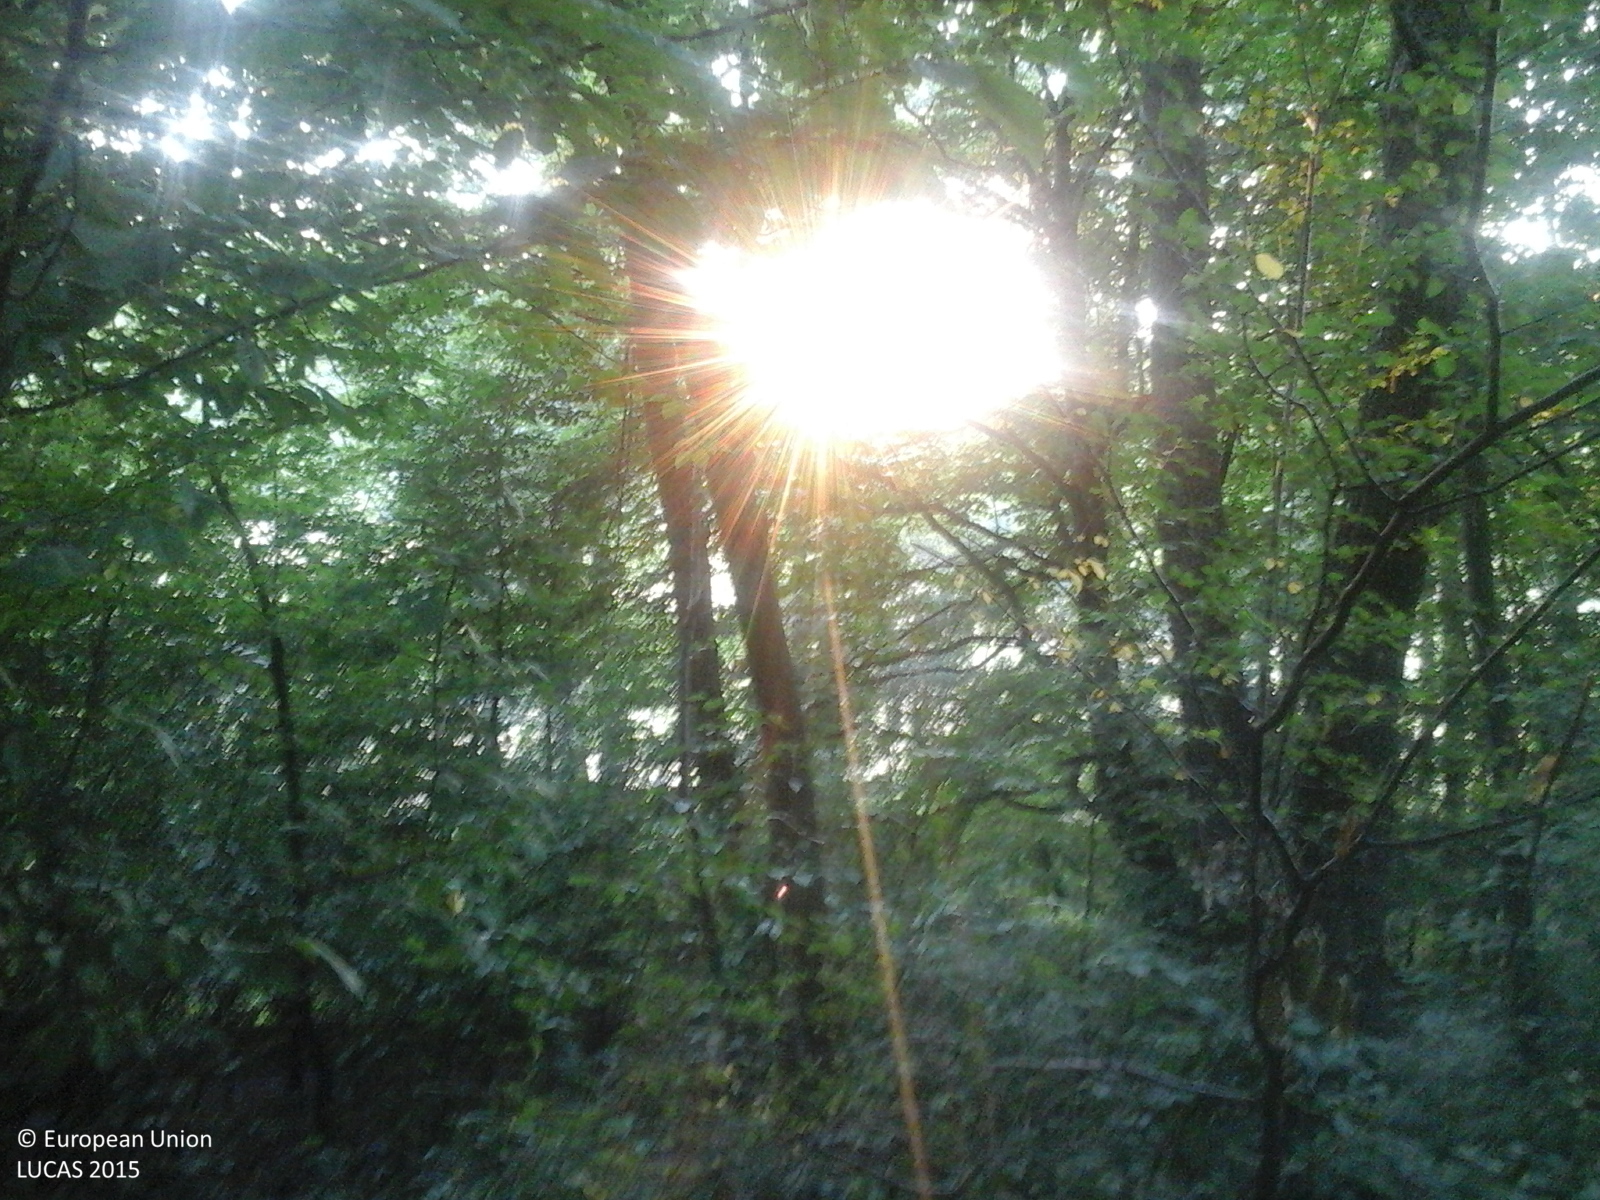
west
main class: Woodland
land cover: Broadleaved woodland
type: beech forest
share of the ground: > 75 %
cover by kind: broadleaved forest trees 100 %
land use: Forestry
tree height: > 5 m
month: July
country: RO
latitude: 44.9632
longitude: 24.5671
